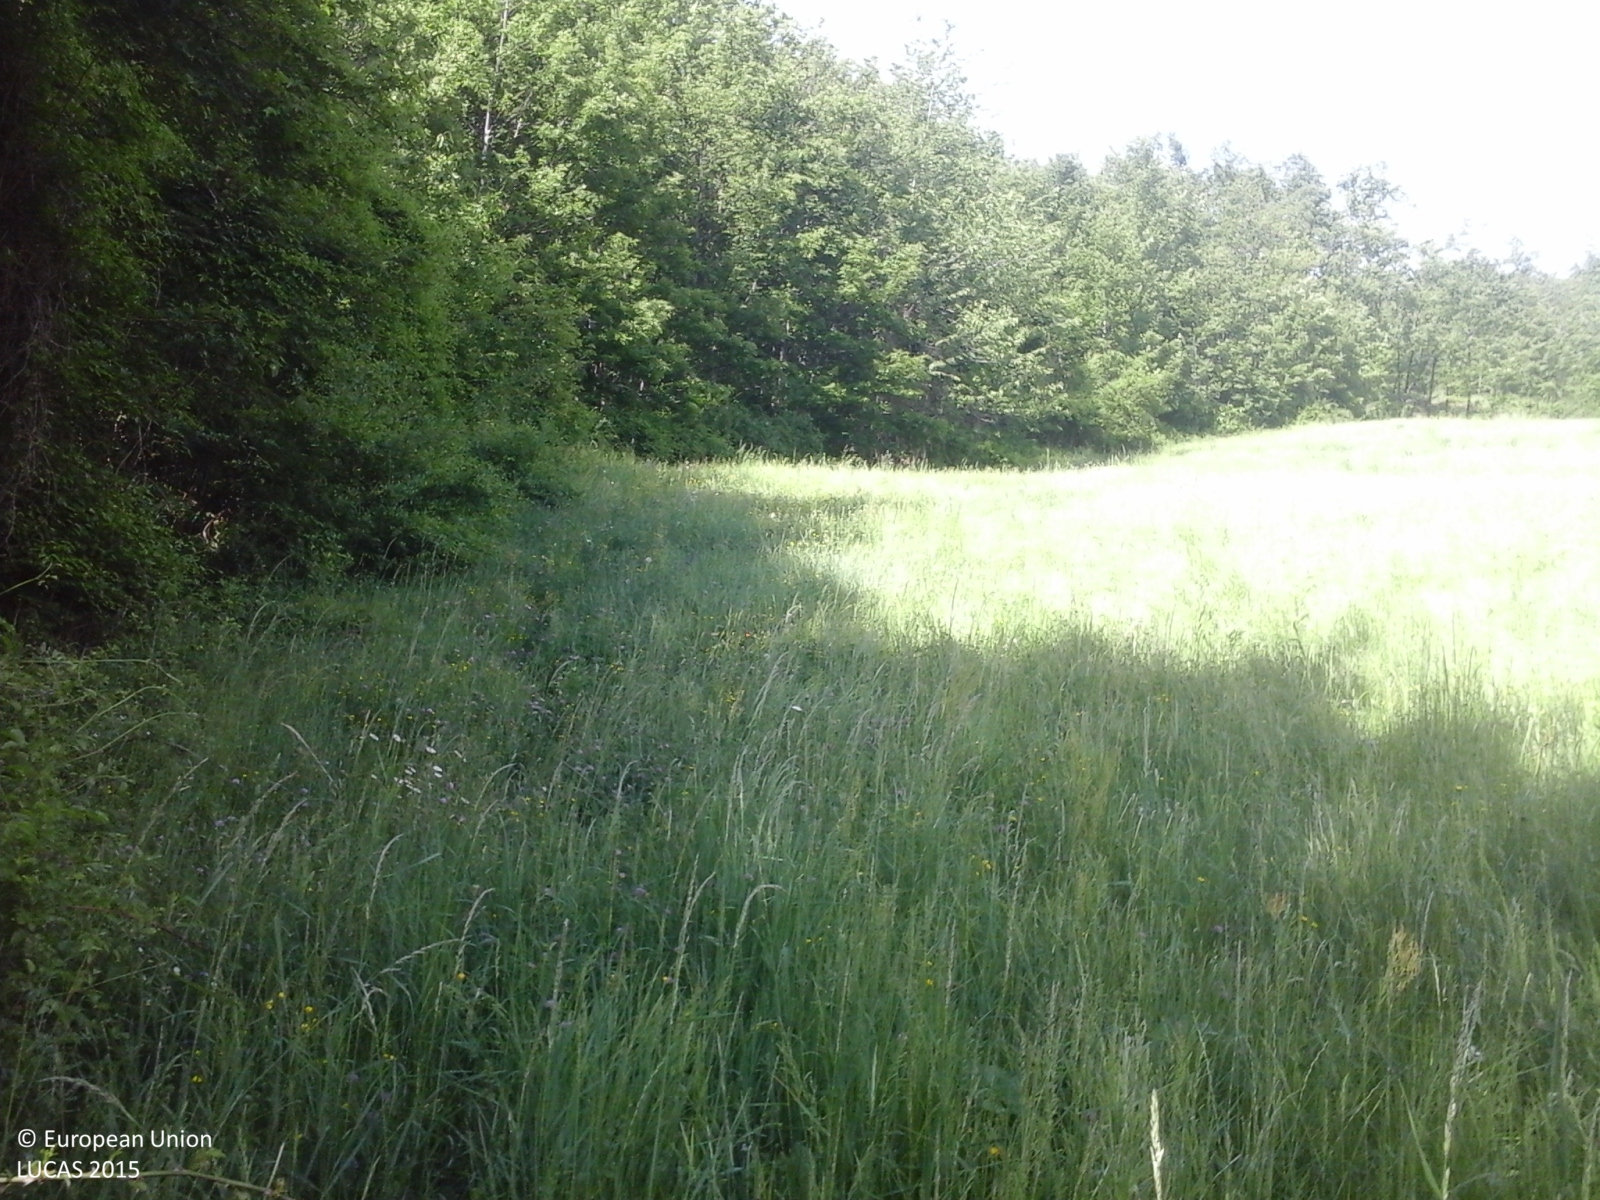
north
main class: Woodland
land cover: Broadleaved woodland
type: thermophilous deciduous forest
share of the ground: > 75 %
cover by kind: broadleaved forest trees 90 %, shrubs 10 %
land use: Forestry
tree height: > 5 m
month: May
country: IT
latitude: 44.2025
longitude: 10.8863
